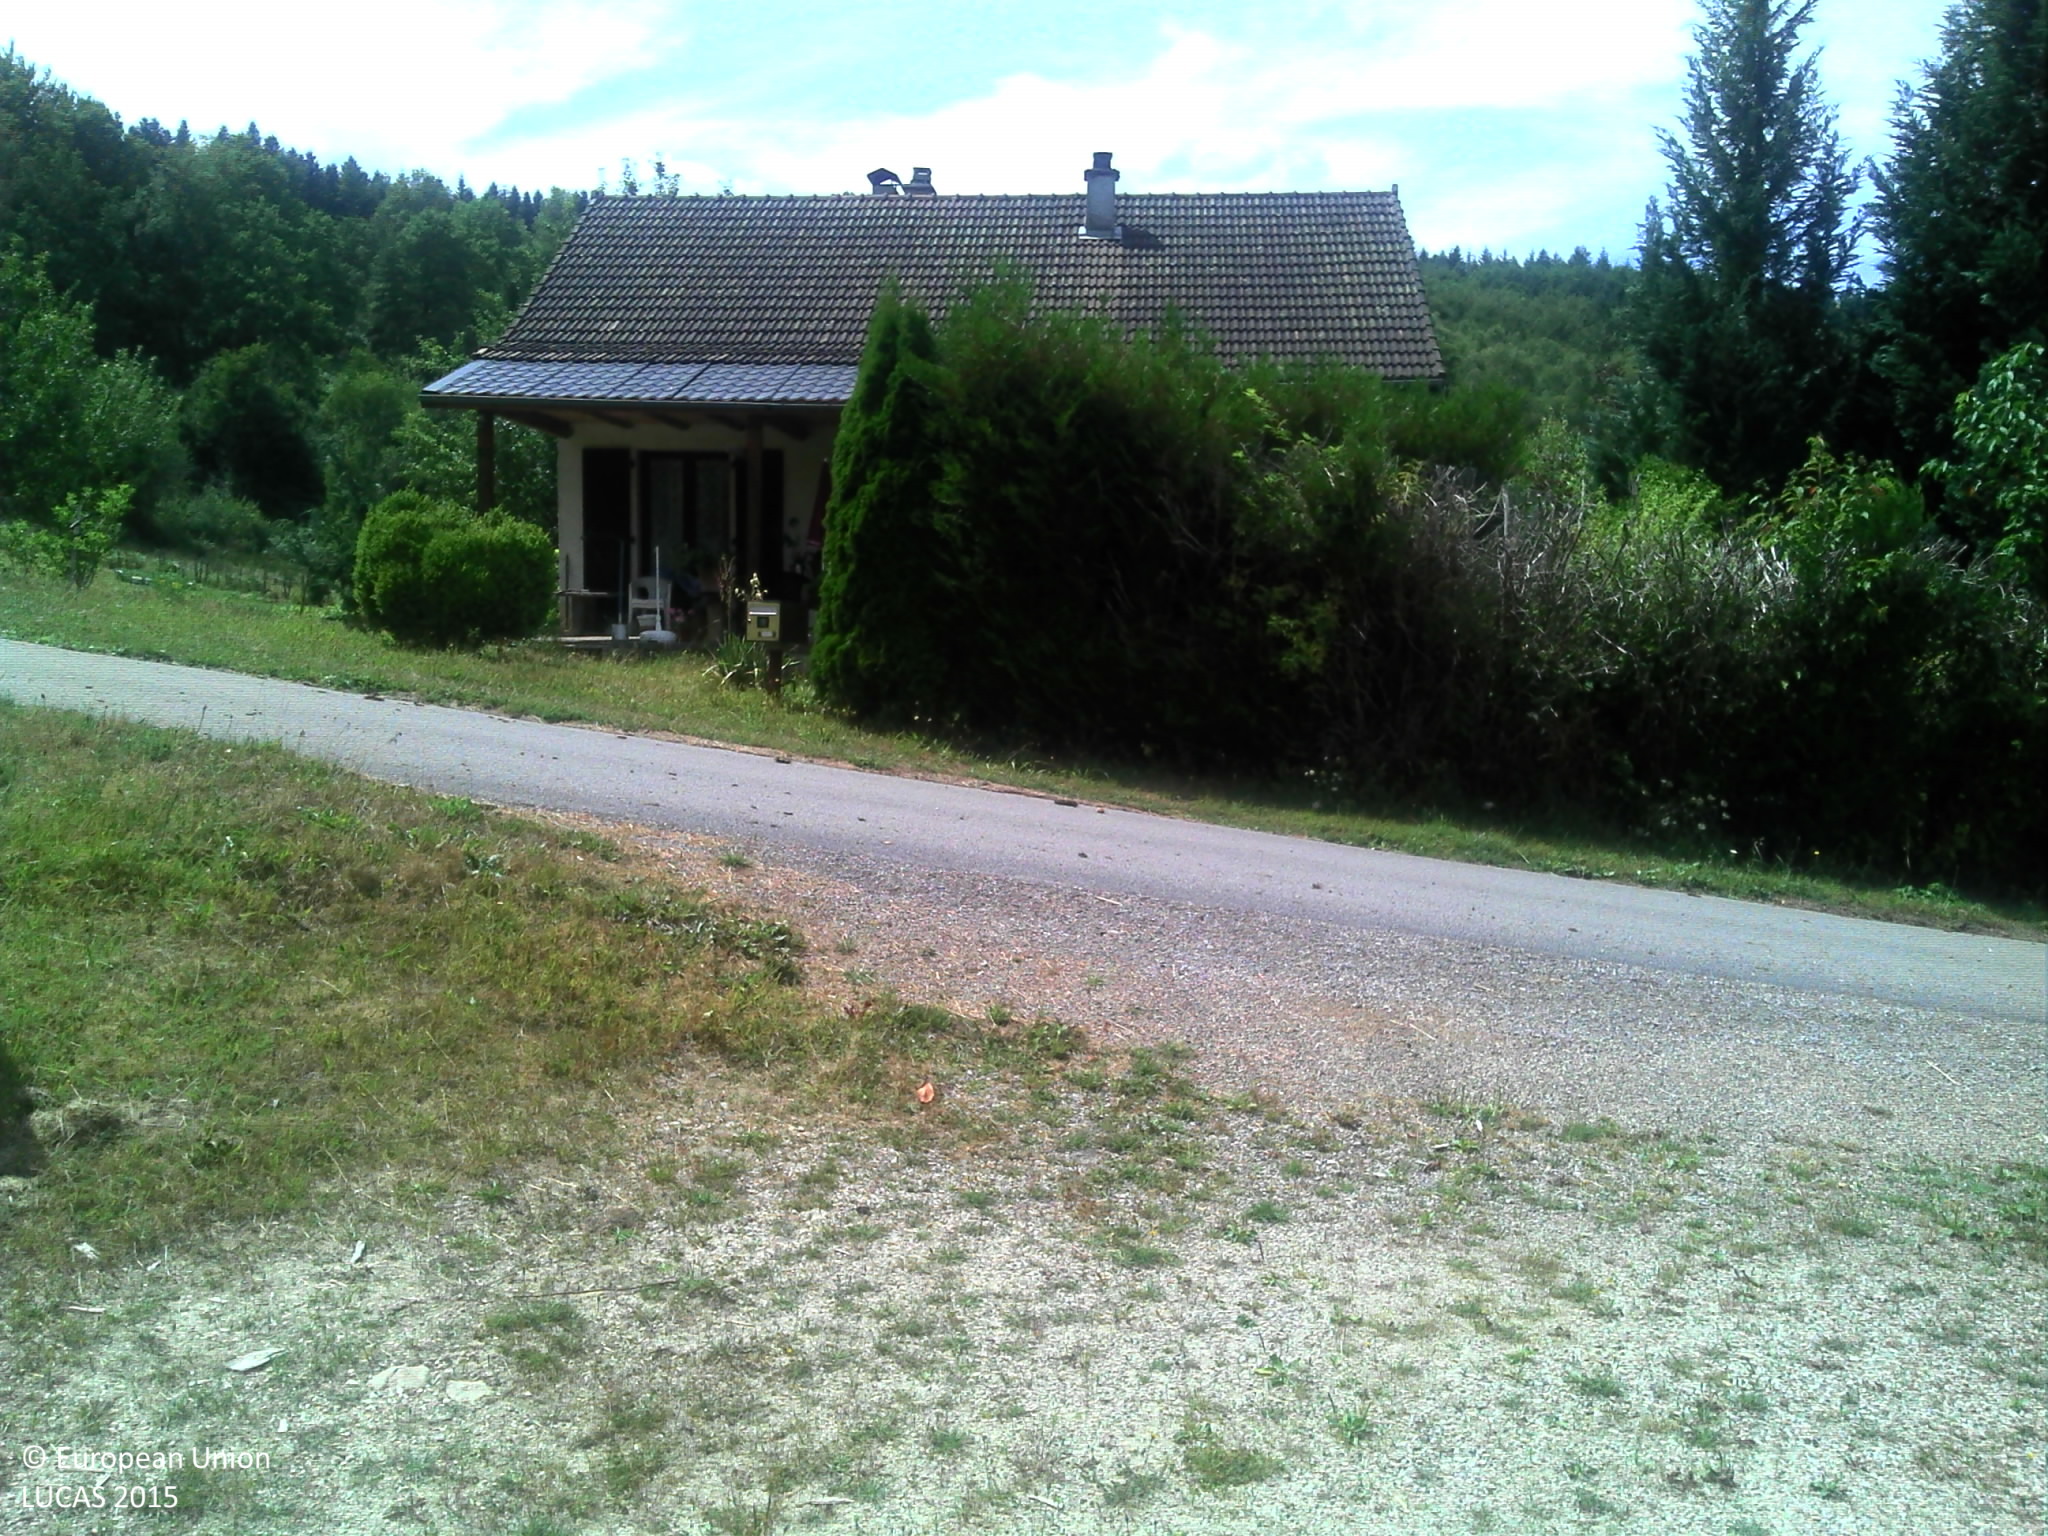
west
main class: Grassland
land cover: Grassland without tree/shrub cover
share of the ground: > 75 %
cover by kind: herbaceous plants 95 %, shrubs 5 %
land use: Forestry
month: July
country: FR
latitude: 45.6395
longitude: 1.8225
